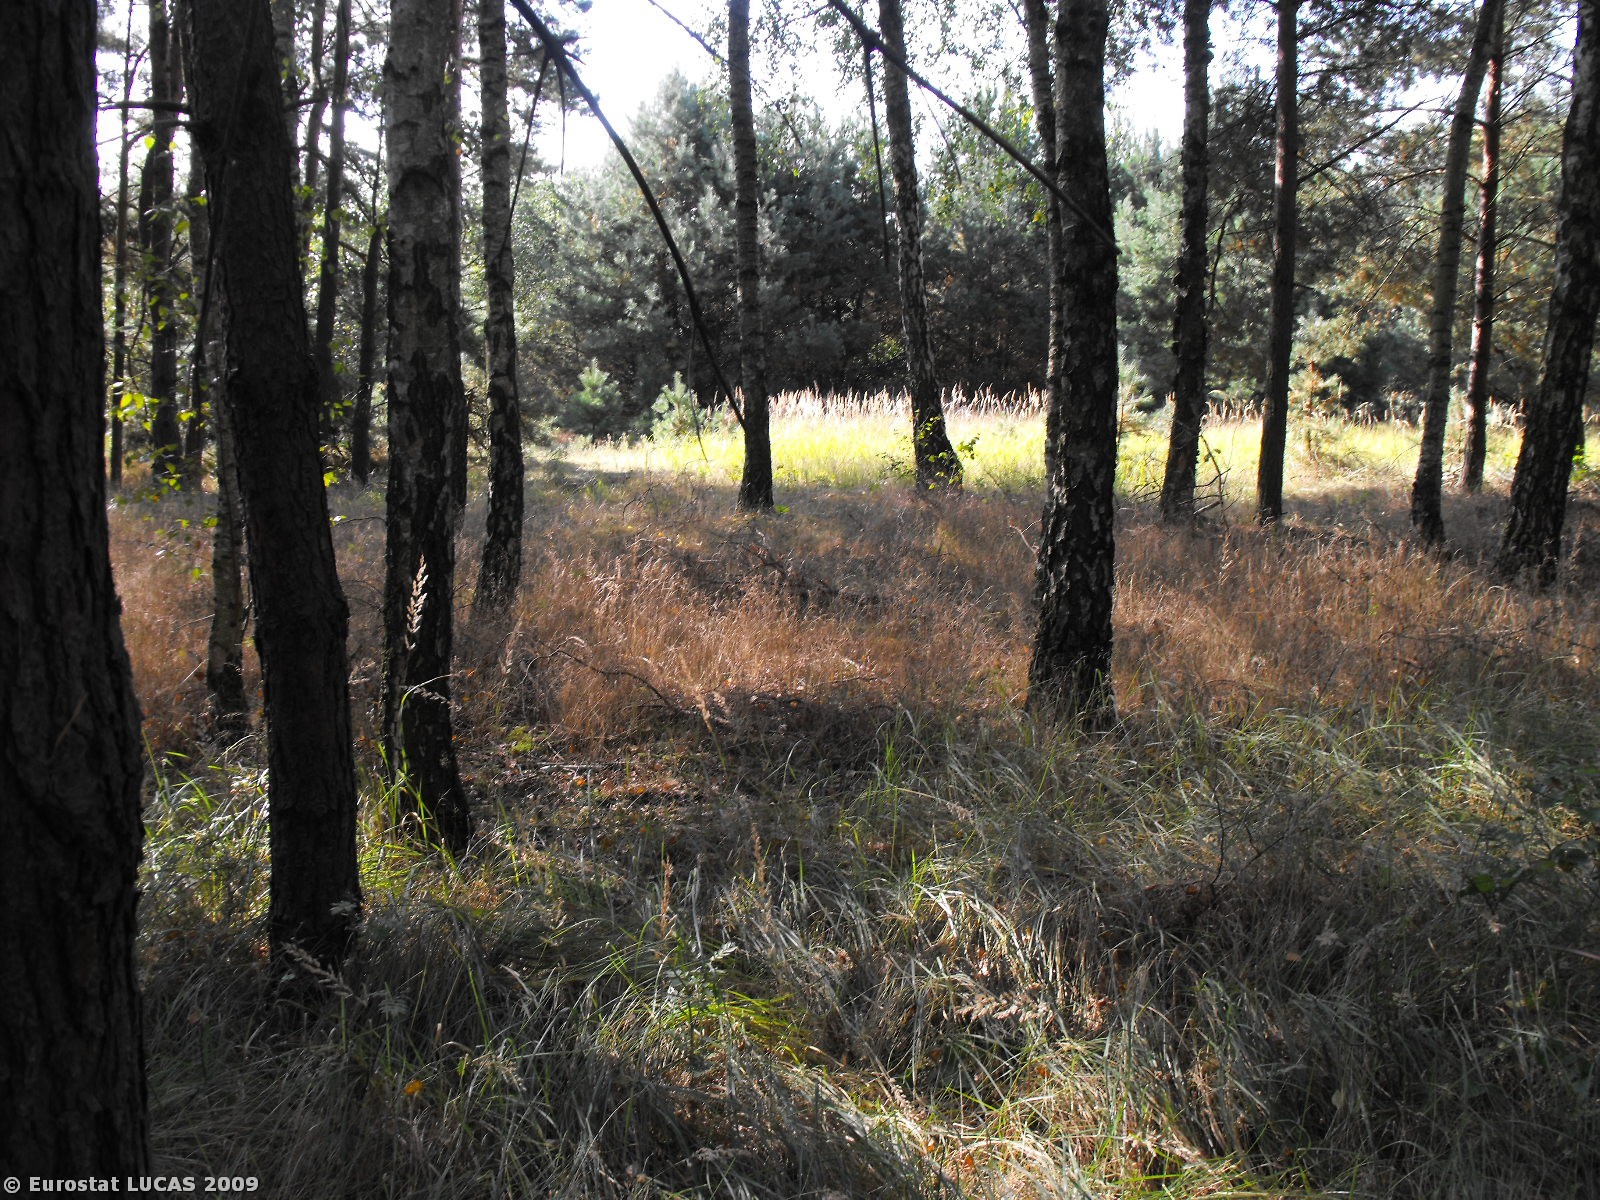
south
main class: Woodland
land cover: Coniferous woodland
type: hemiboreal forest and nemoral coniferous forest and mixed broadleaved-coniferous forest
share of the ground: > 75 %
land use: Forestry
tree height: > 5 m
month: September
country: PL
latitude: 52.3362
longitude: 16.3028
